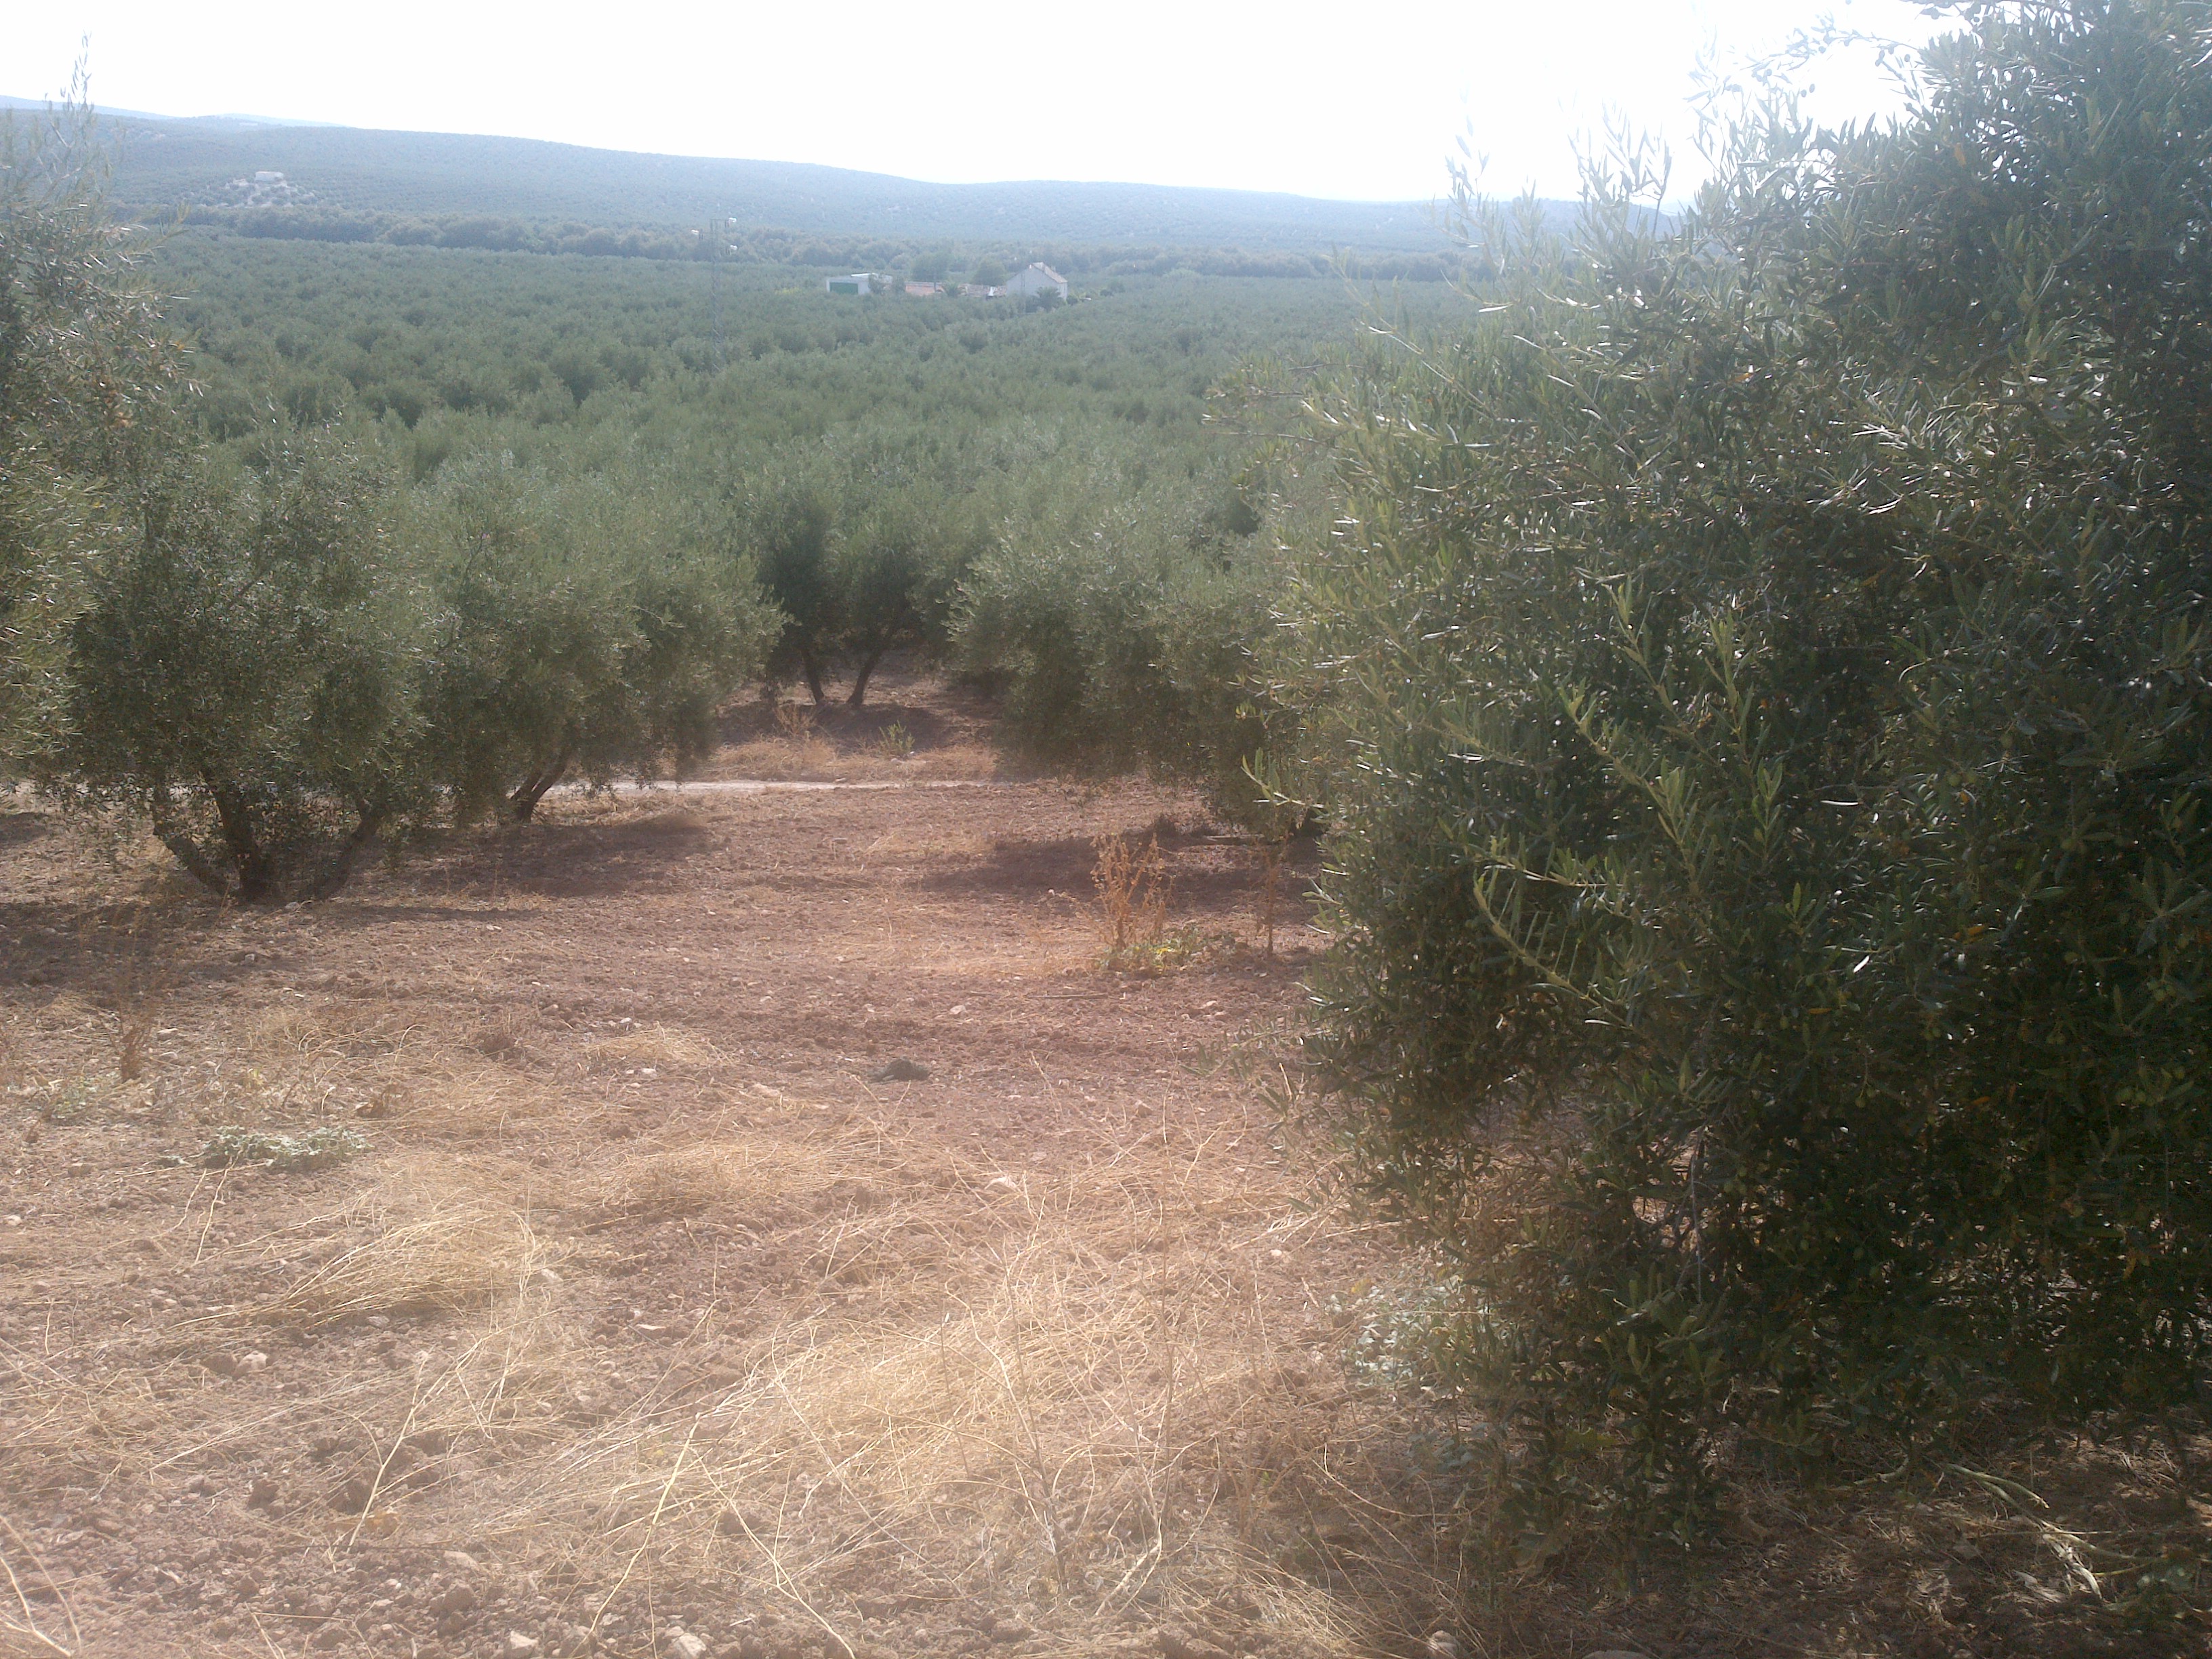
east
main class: Cropland
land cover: Olive groves
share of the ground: 50 - 75 %
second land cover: Other bare soil
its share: > 75 %
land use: Agriculture (excluding fallow land and kitchen gardens)
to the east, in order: Olive groves; Other bare soil; Tracks; Grass margins; Olive groves; Electric lines; Olive groves
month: June
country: ES
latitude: 37.6782
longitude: -4.2569
